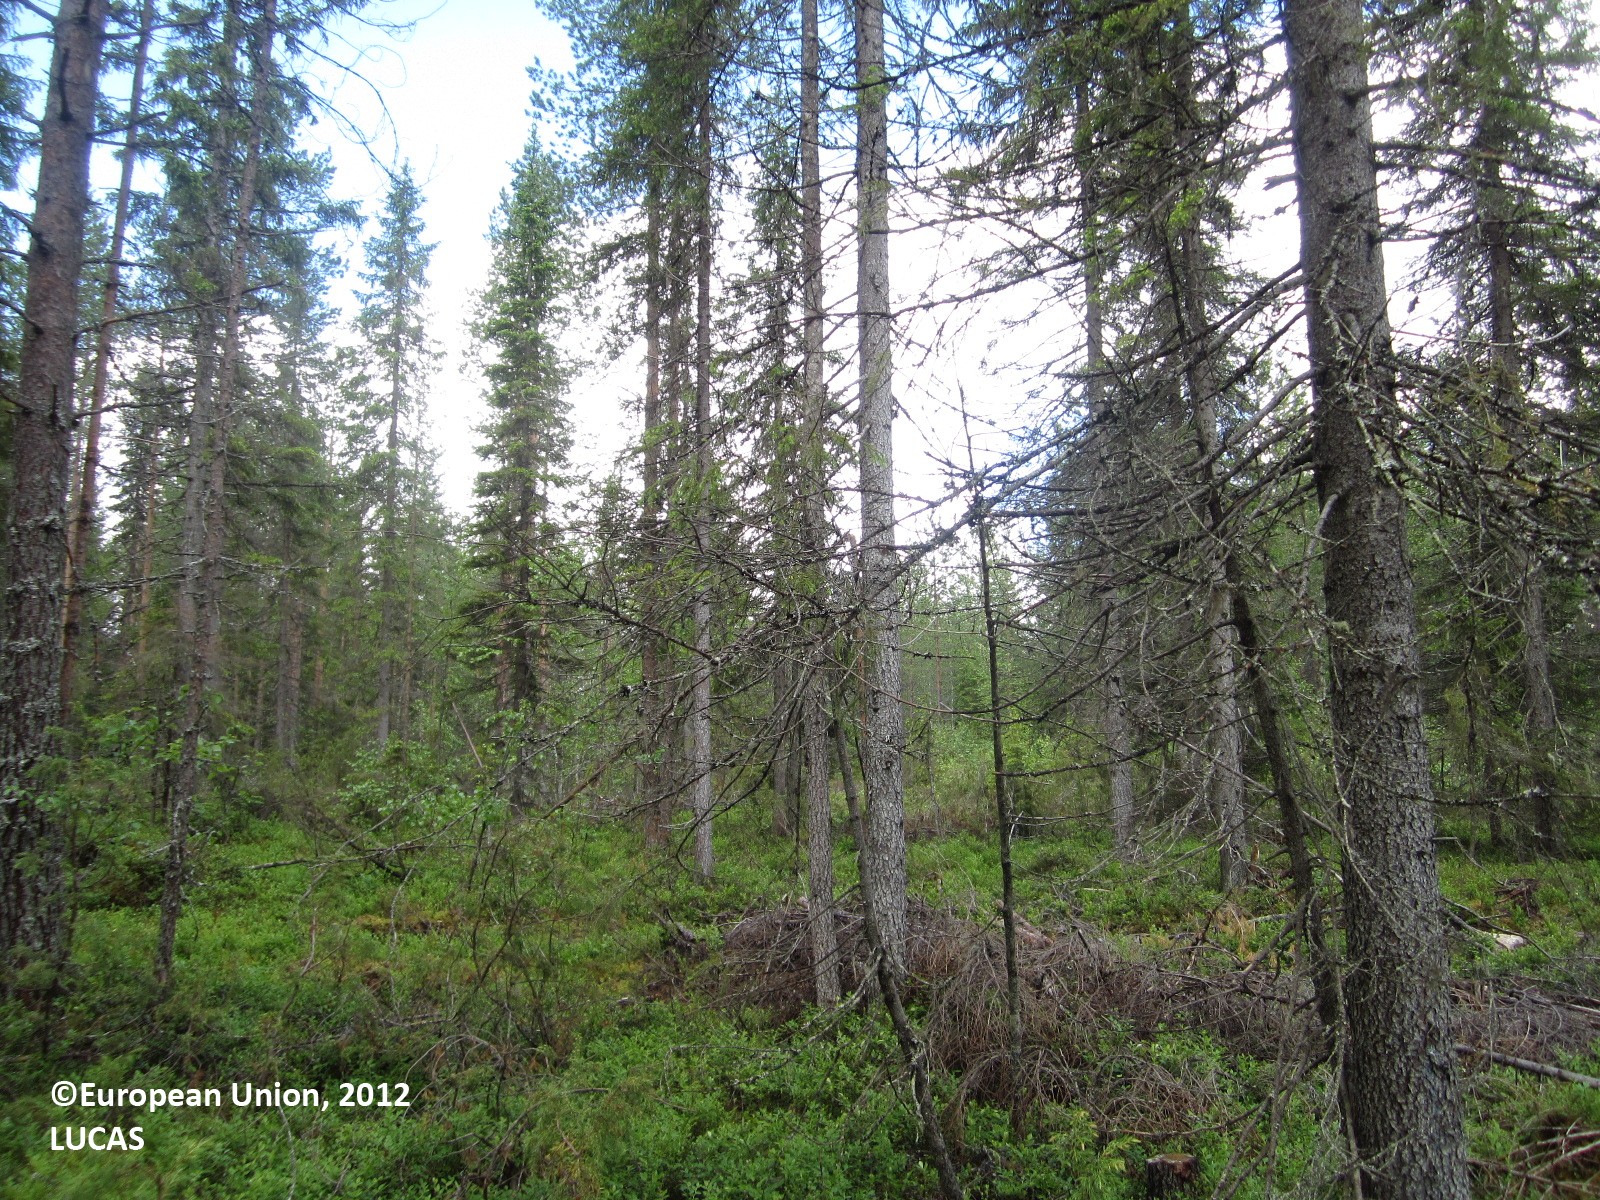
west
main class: Woodland
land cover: Spruce dominated coniferous woodland
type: boreal forest
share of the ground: > 75 %
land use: Forestry
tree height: > 5 m
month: June
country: FI
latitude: 64.4603
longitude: 29.6574
